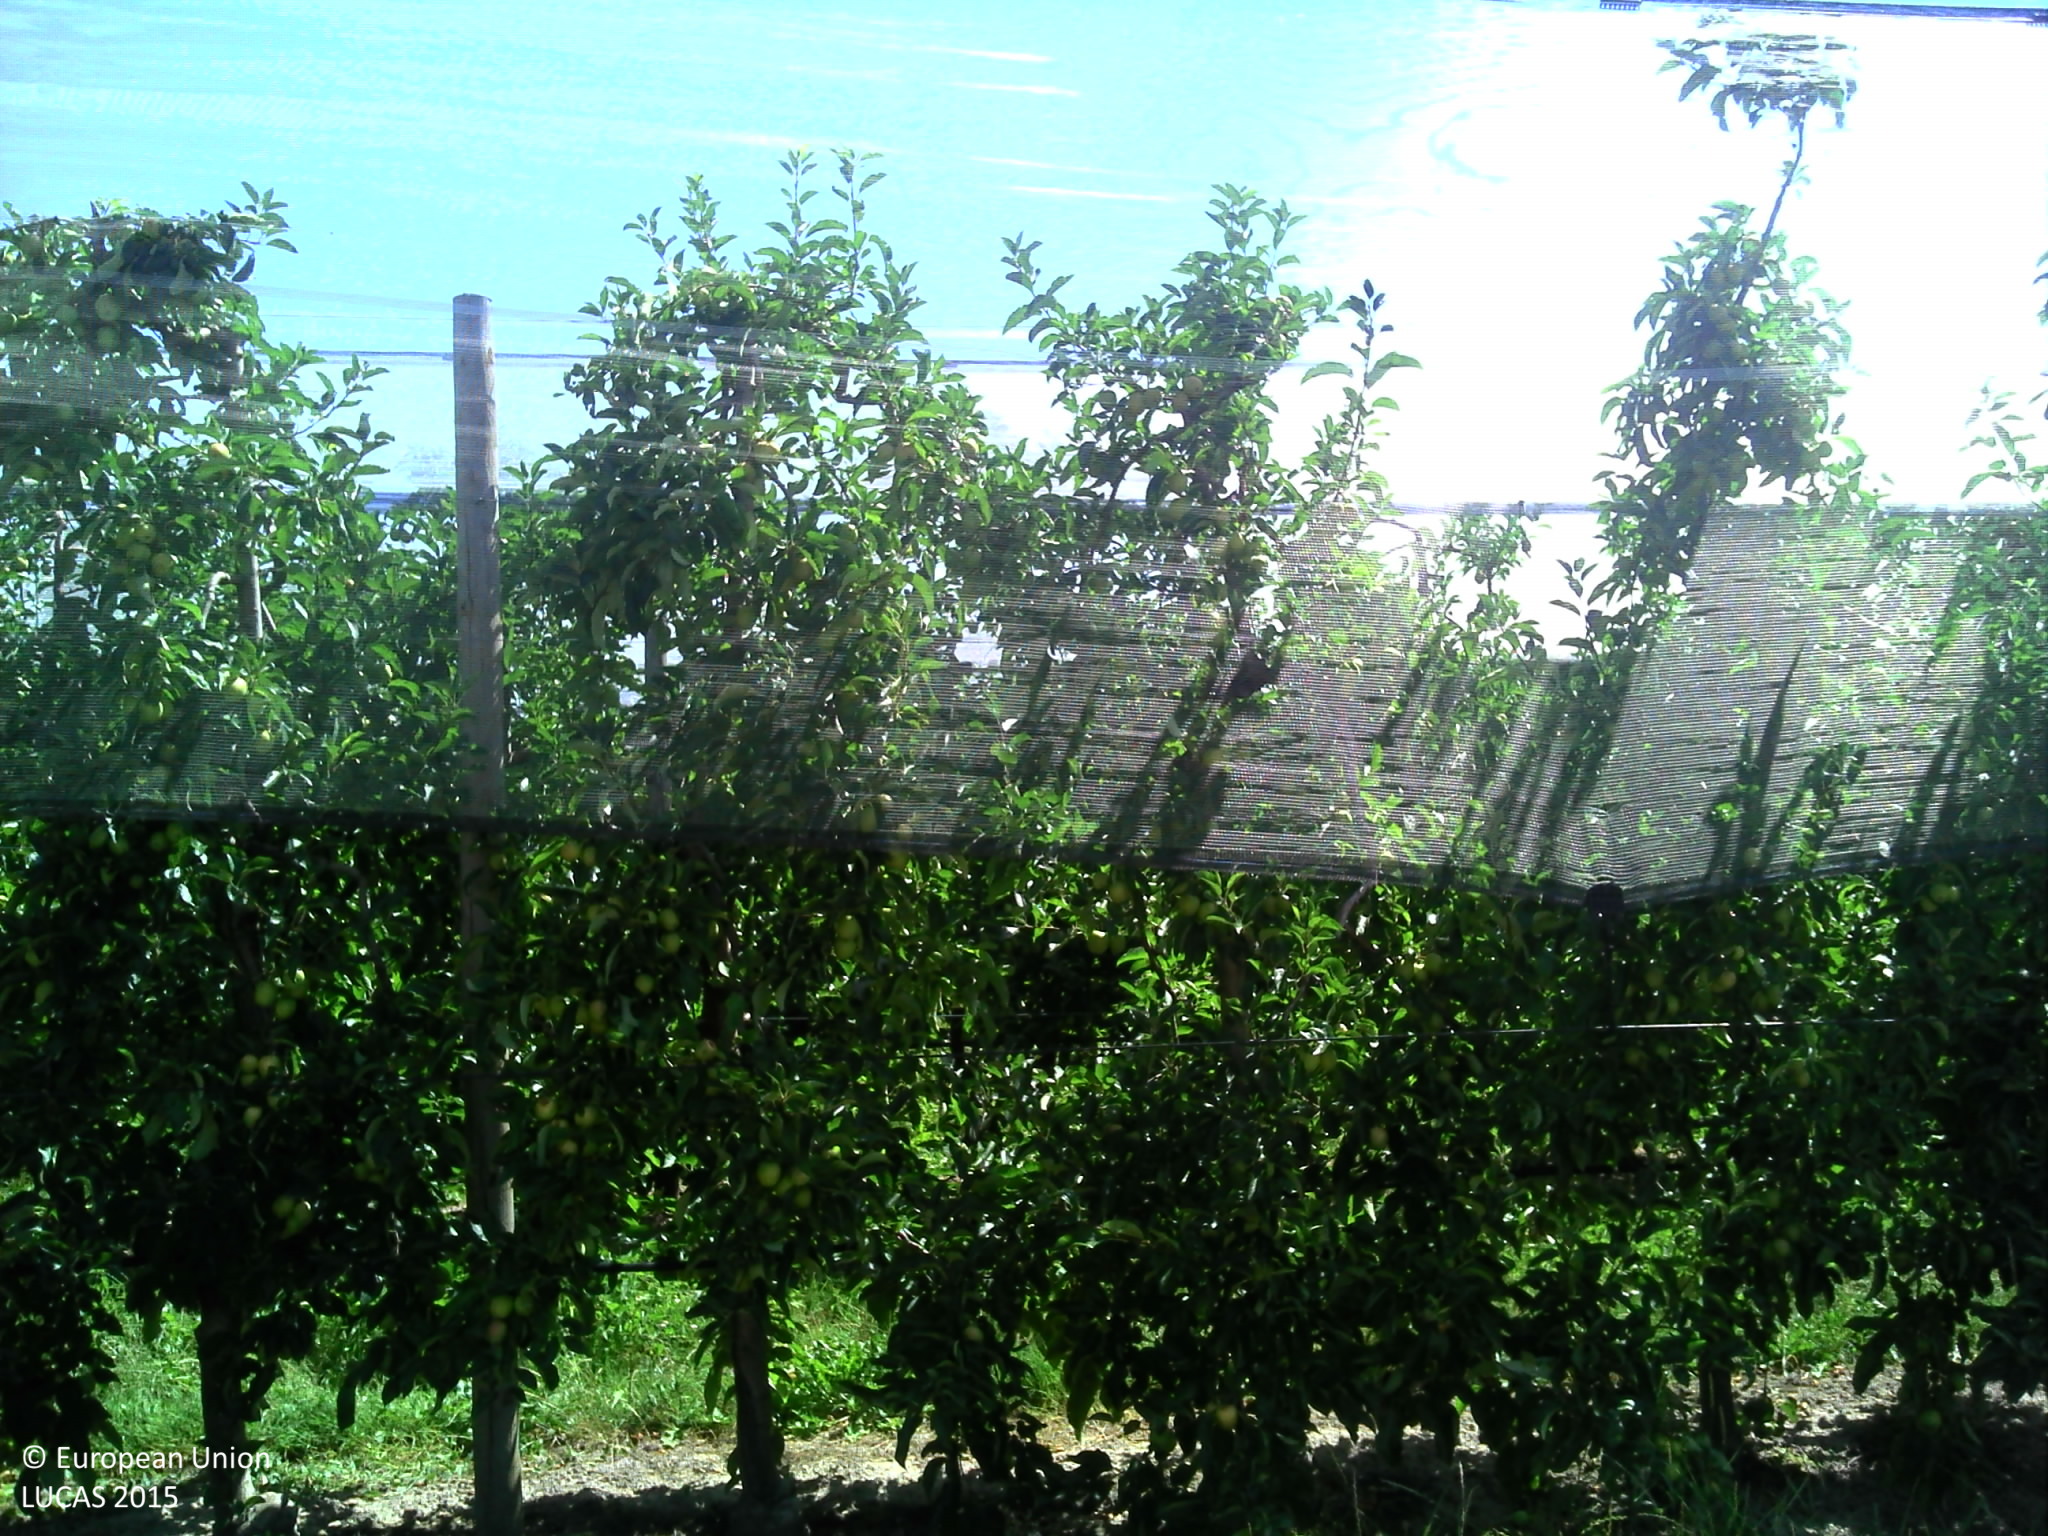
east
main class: Cropland
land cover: Common wheat
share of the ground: > 75 %
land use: Agriculture (excluding fallow land and kitchen gardens)
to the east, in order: Common wheat; Grass margins; Tracks; Grass margins; Apple fruit; Artificial constructions in urban areas; Inland fresh water bodies; Broadleaved woodland; Grassland without tree/shrub cover; Common wheat
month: July
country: FR
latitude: 47.6365
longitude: 0.3539
